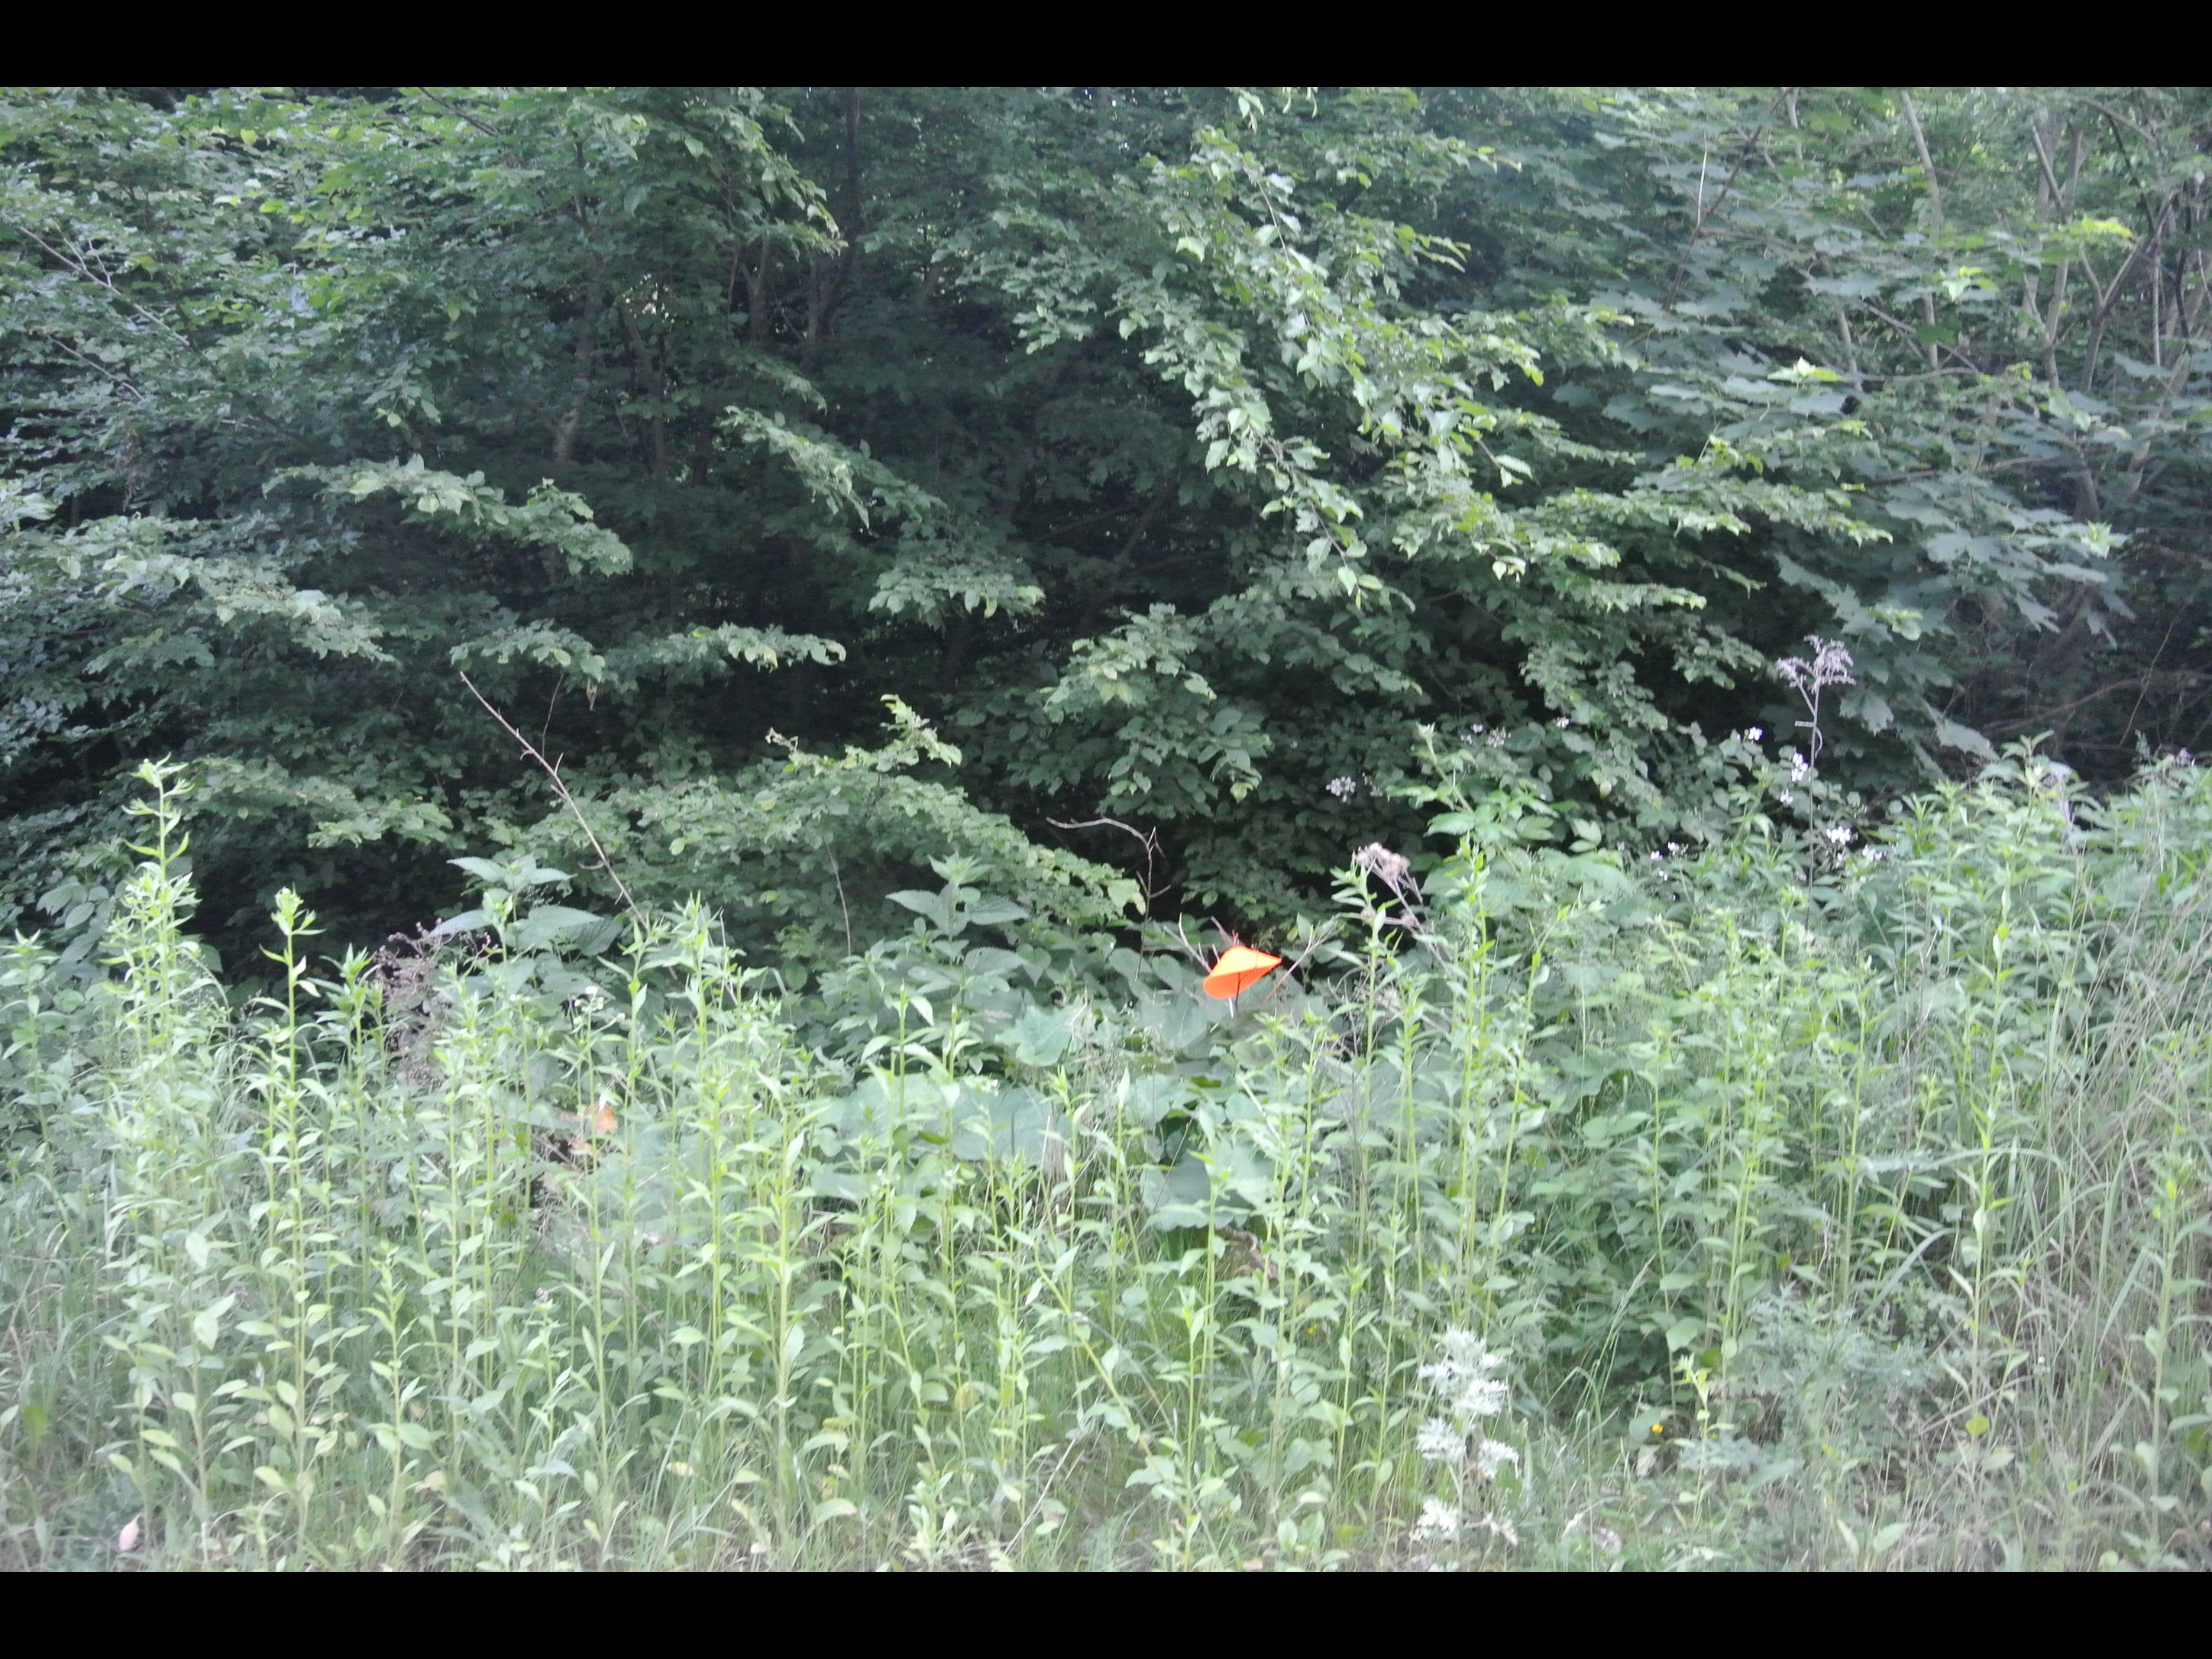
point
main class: Woodland
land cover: Broadleaved woodland
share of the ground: 50 - 75 %
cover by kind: broadleaved forest trees 75 %, herbaceous plants 25 %
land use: Forestry
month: June
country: AT
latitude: 47.8830
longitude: 16.5709
